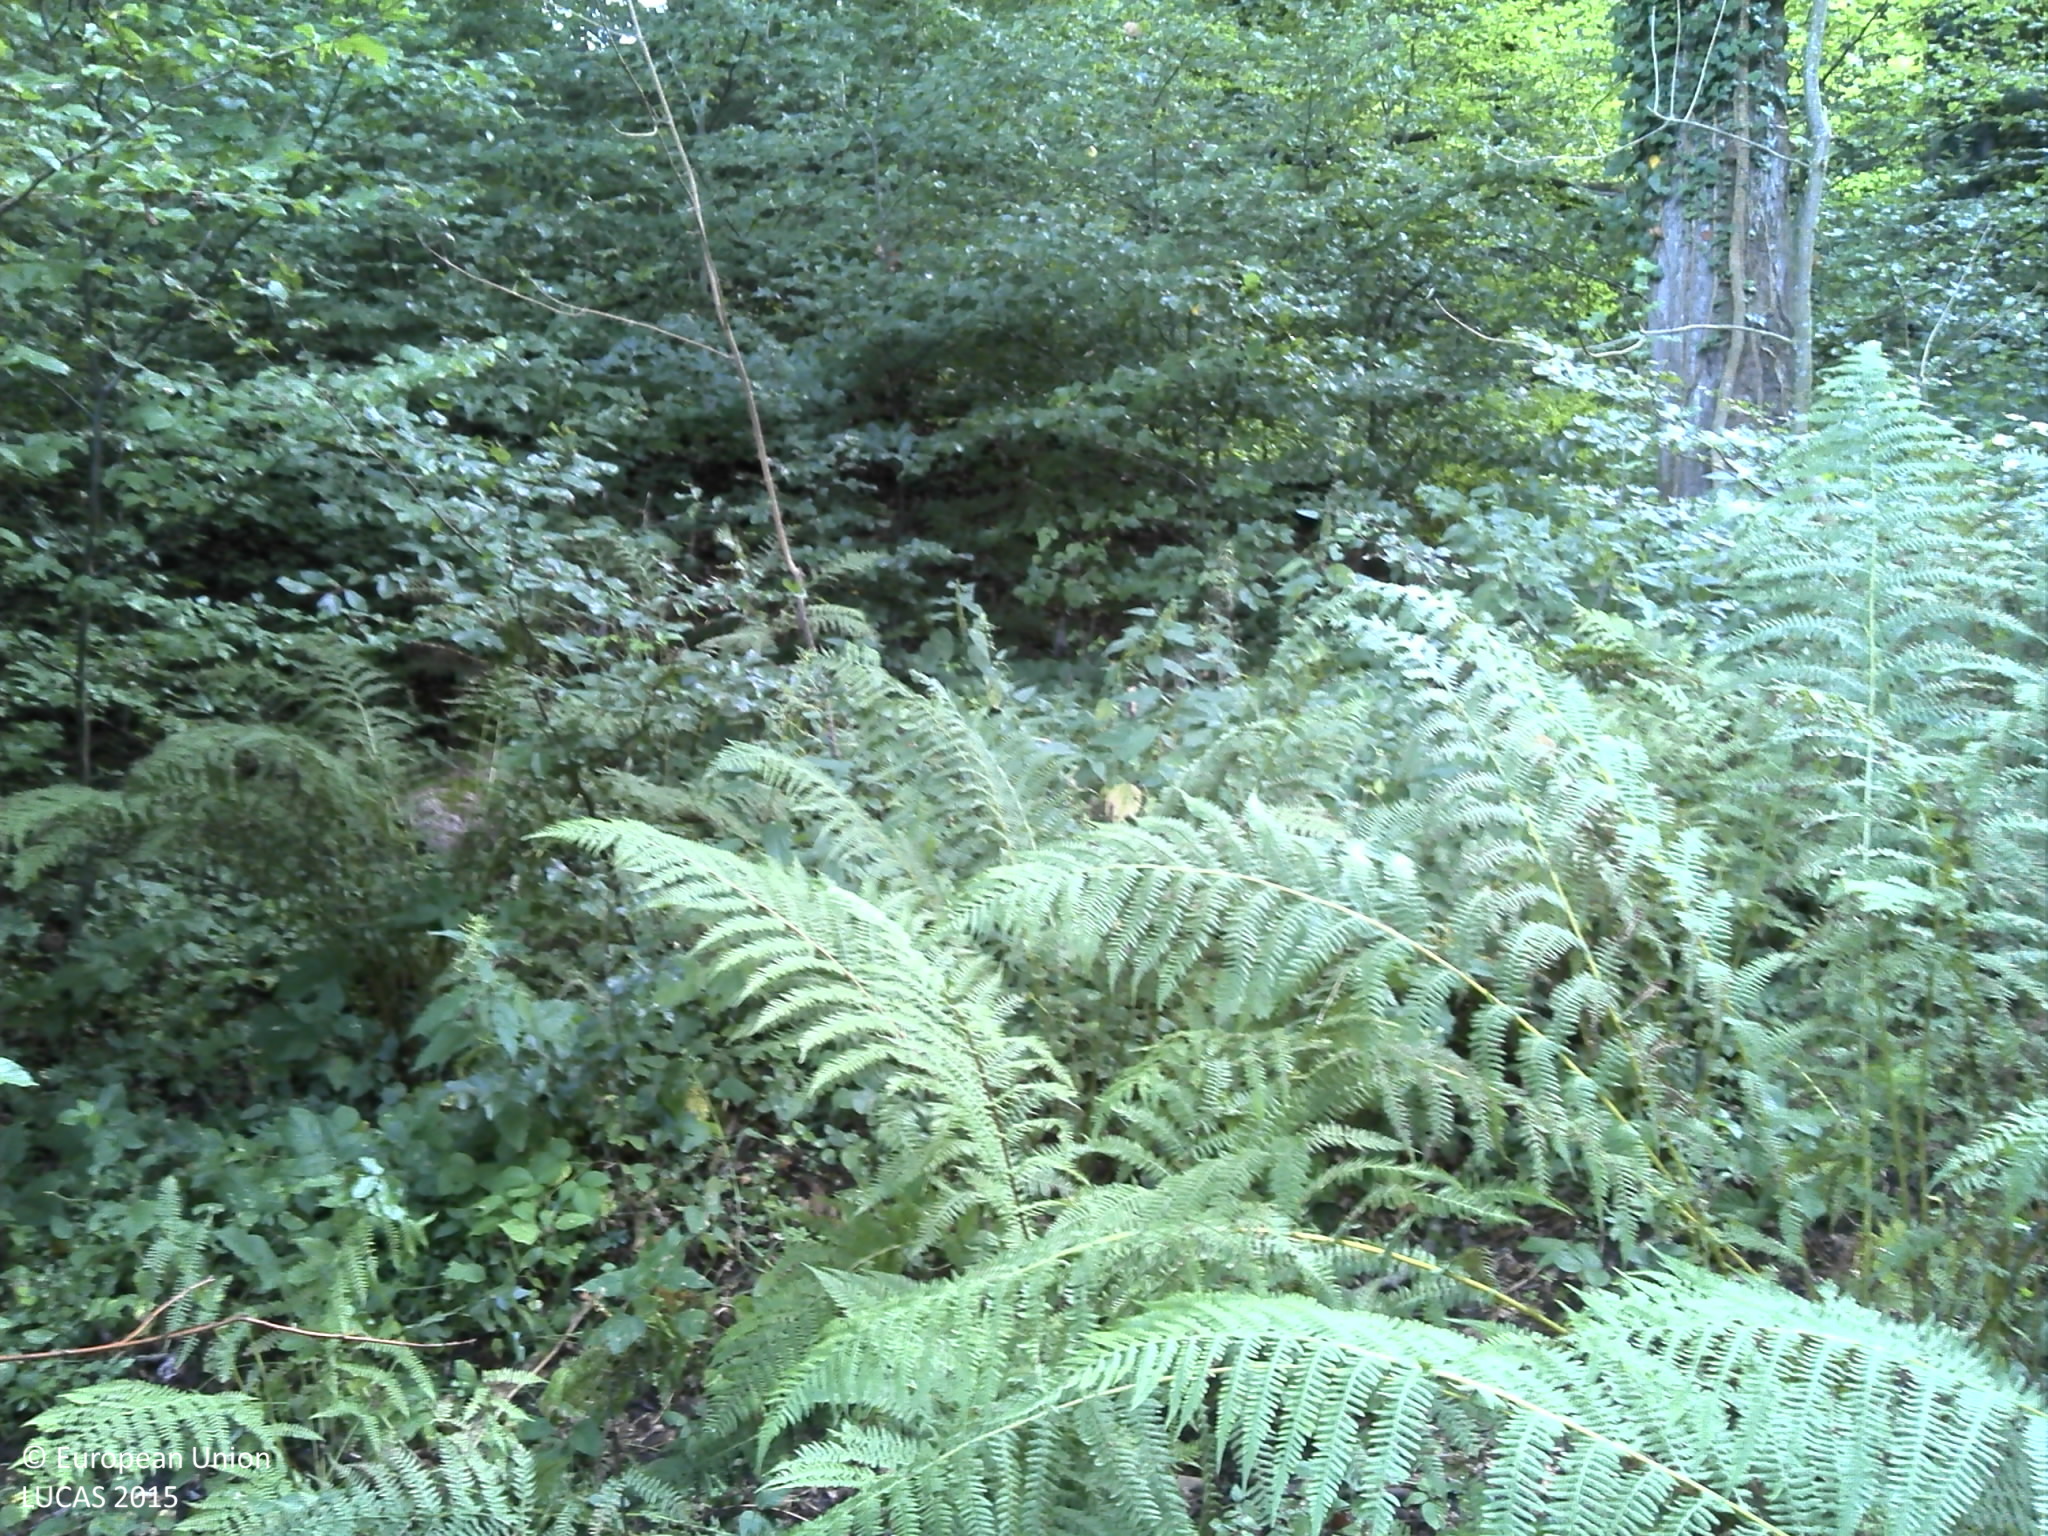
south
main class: Woodland
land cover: Broadleaved woodland
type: beech forest
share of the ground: > 75 %
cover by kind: broadleaved forest trees 85 %, herbaceous plants 10 %, consolidated bare surface 5 %
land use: Forestry
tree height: > 5 m
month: August
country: LU
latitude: 49.6497
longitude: 6.1074
